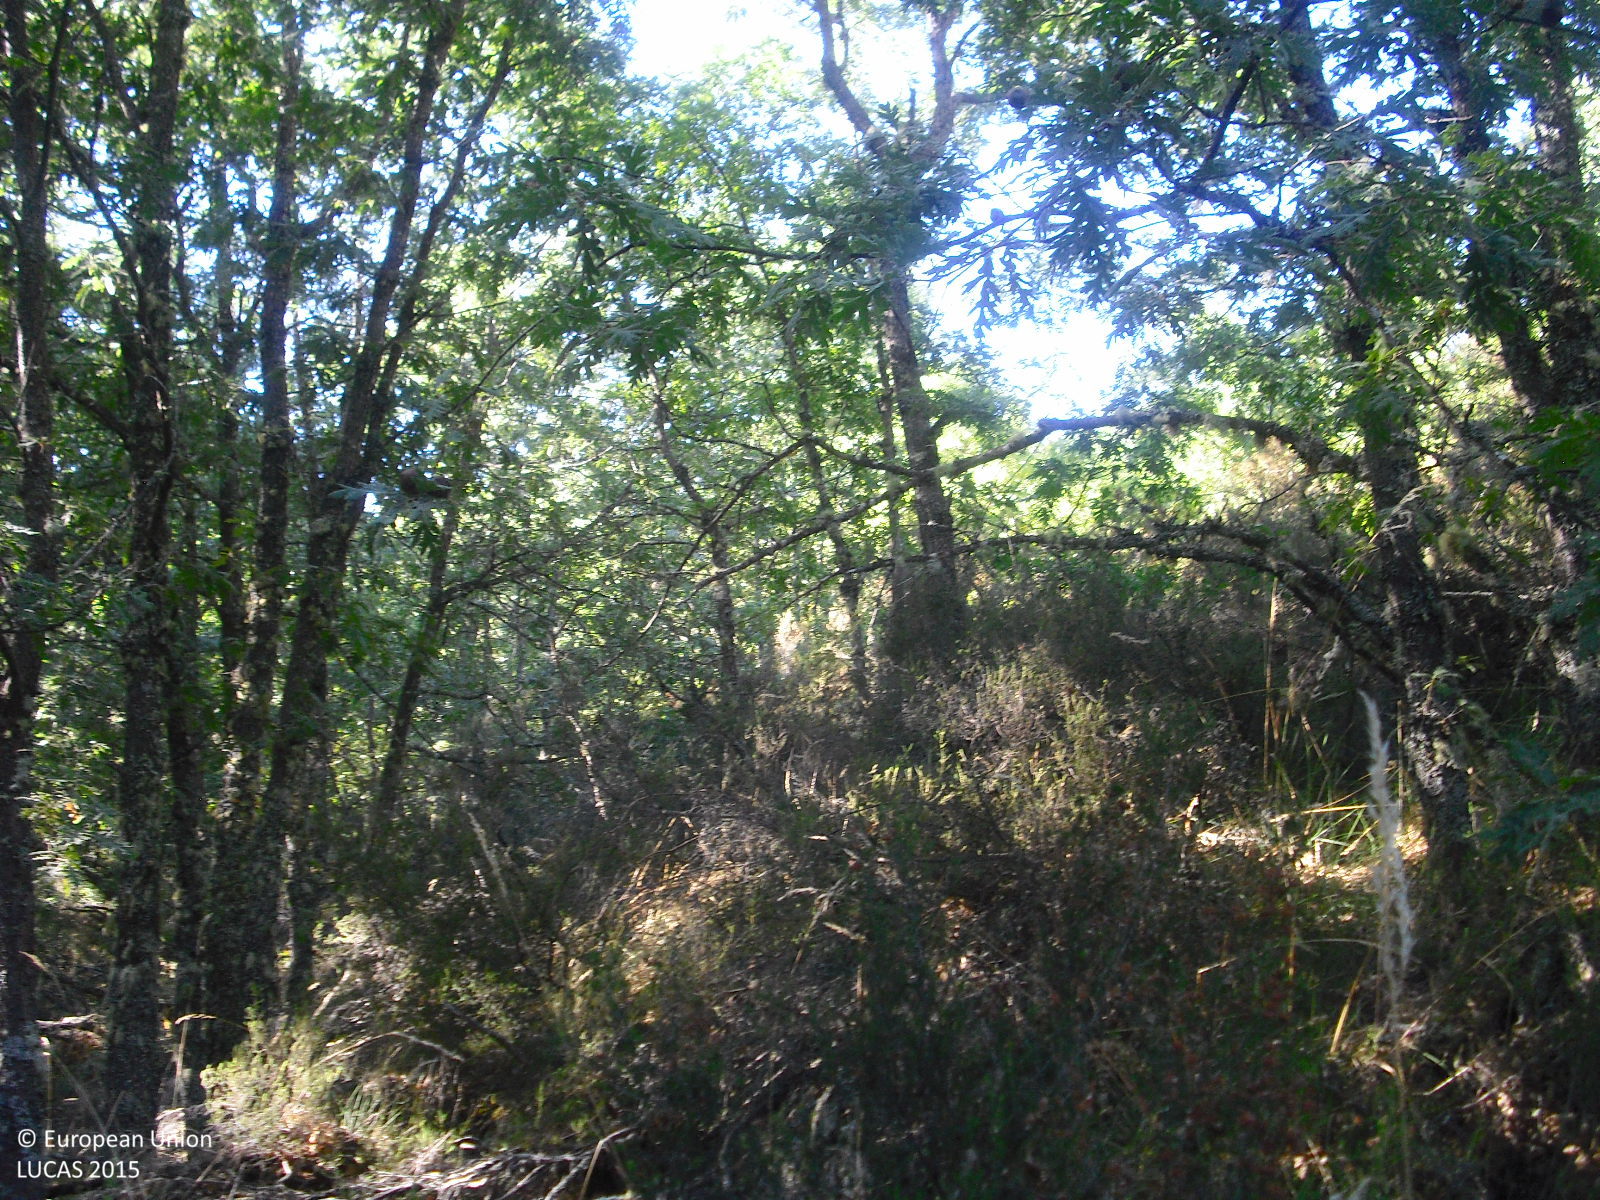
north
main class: Woodland
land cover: Pine dominated mixed woodland
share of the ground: 25 - 50 %
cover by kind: shrubs 60 %, coniferous forest trees 25 %, broadleaved forest trees 15 %
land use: Forestry
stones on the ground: > 50 %
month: August
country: ES
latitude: 42.4926
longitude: -7.0048
